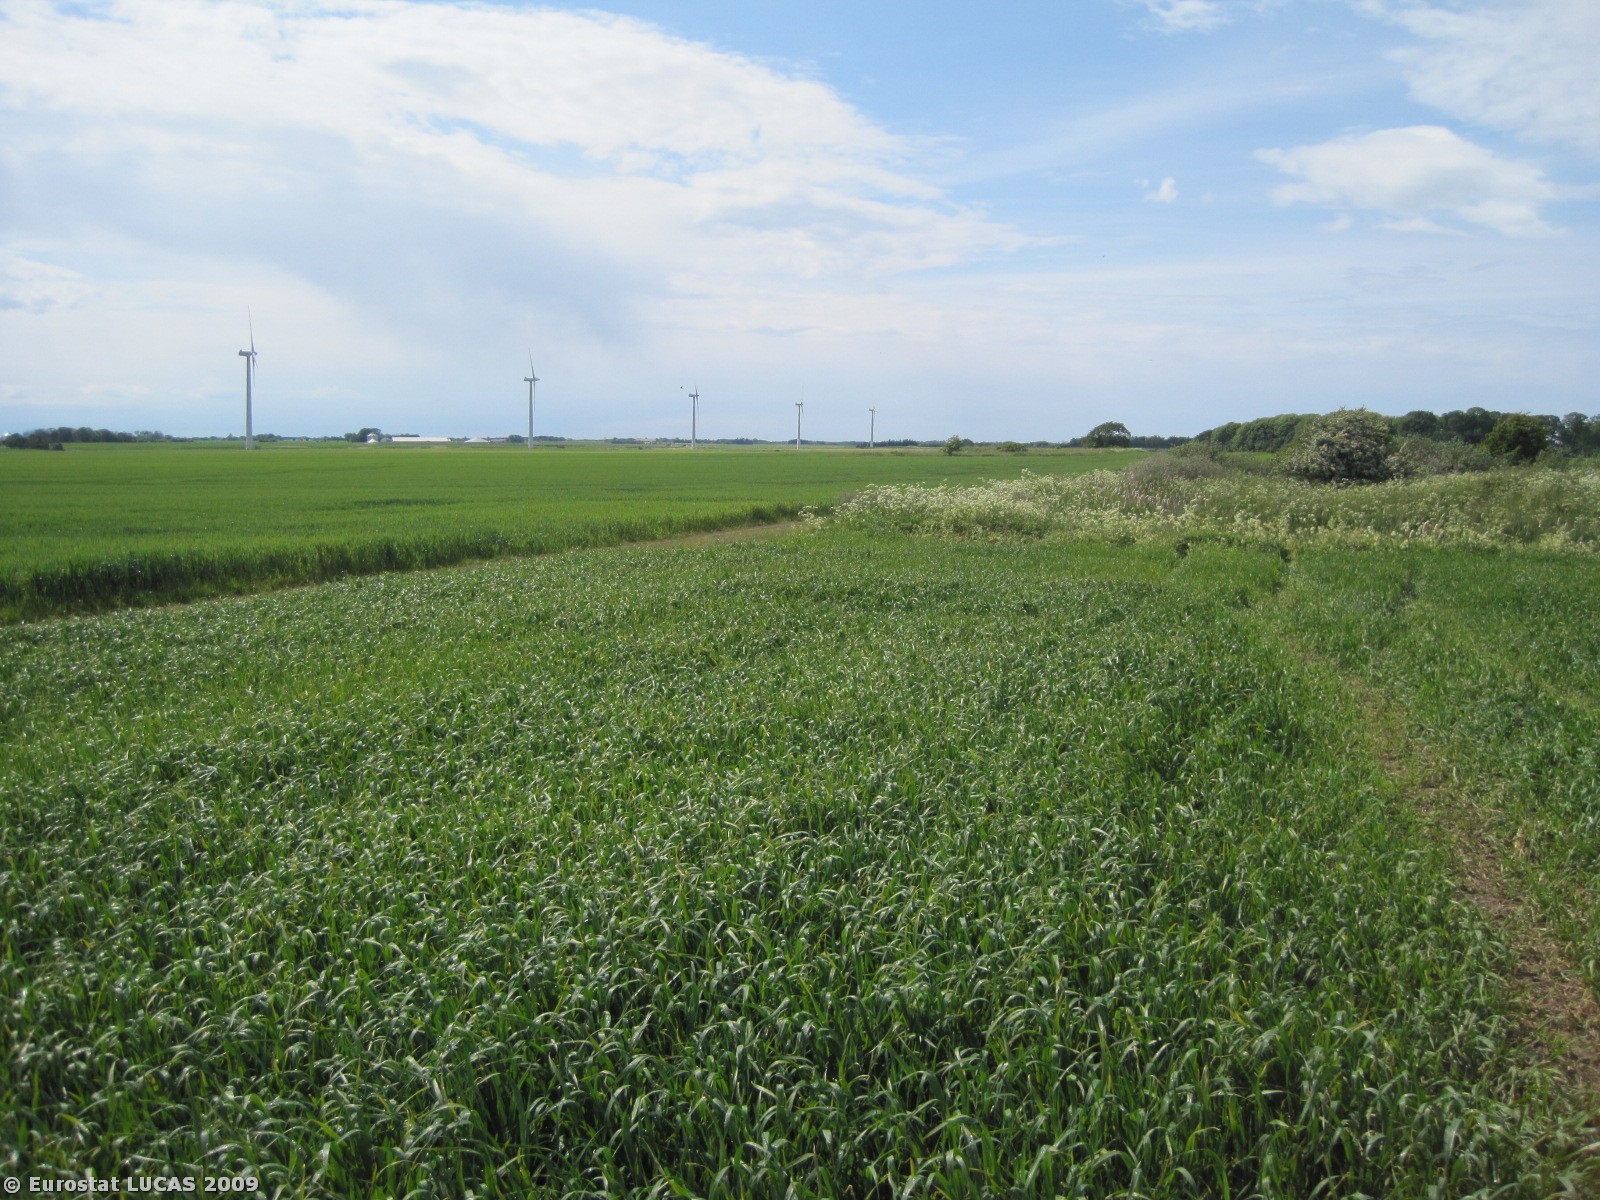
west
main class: Cropland
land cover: Rye
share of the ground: > 75 %
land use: Agriculture (excluding fallow land and kitchen gardens)
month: June
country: DK
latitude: 57.3382
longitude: 9.8507
